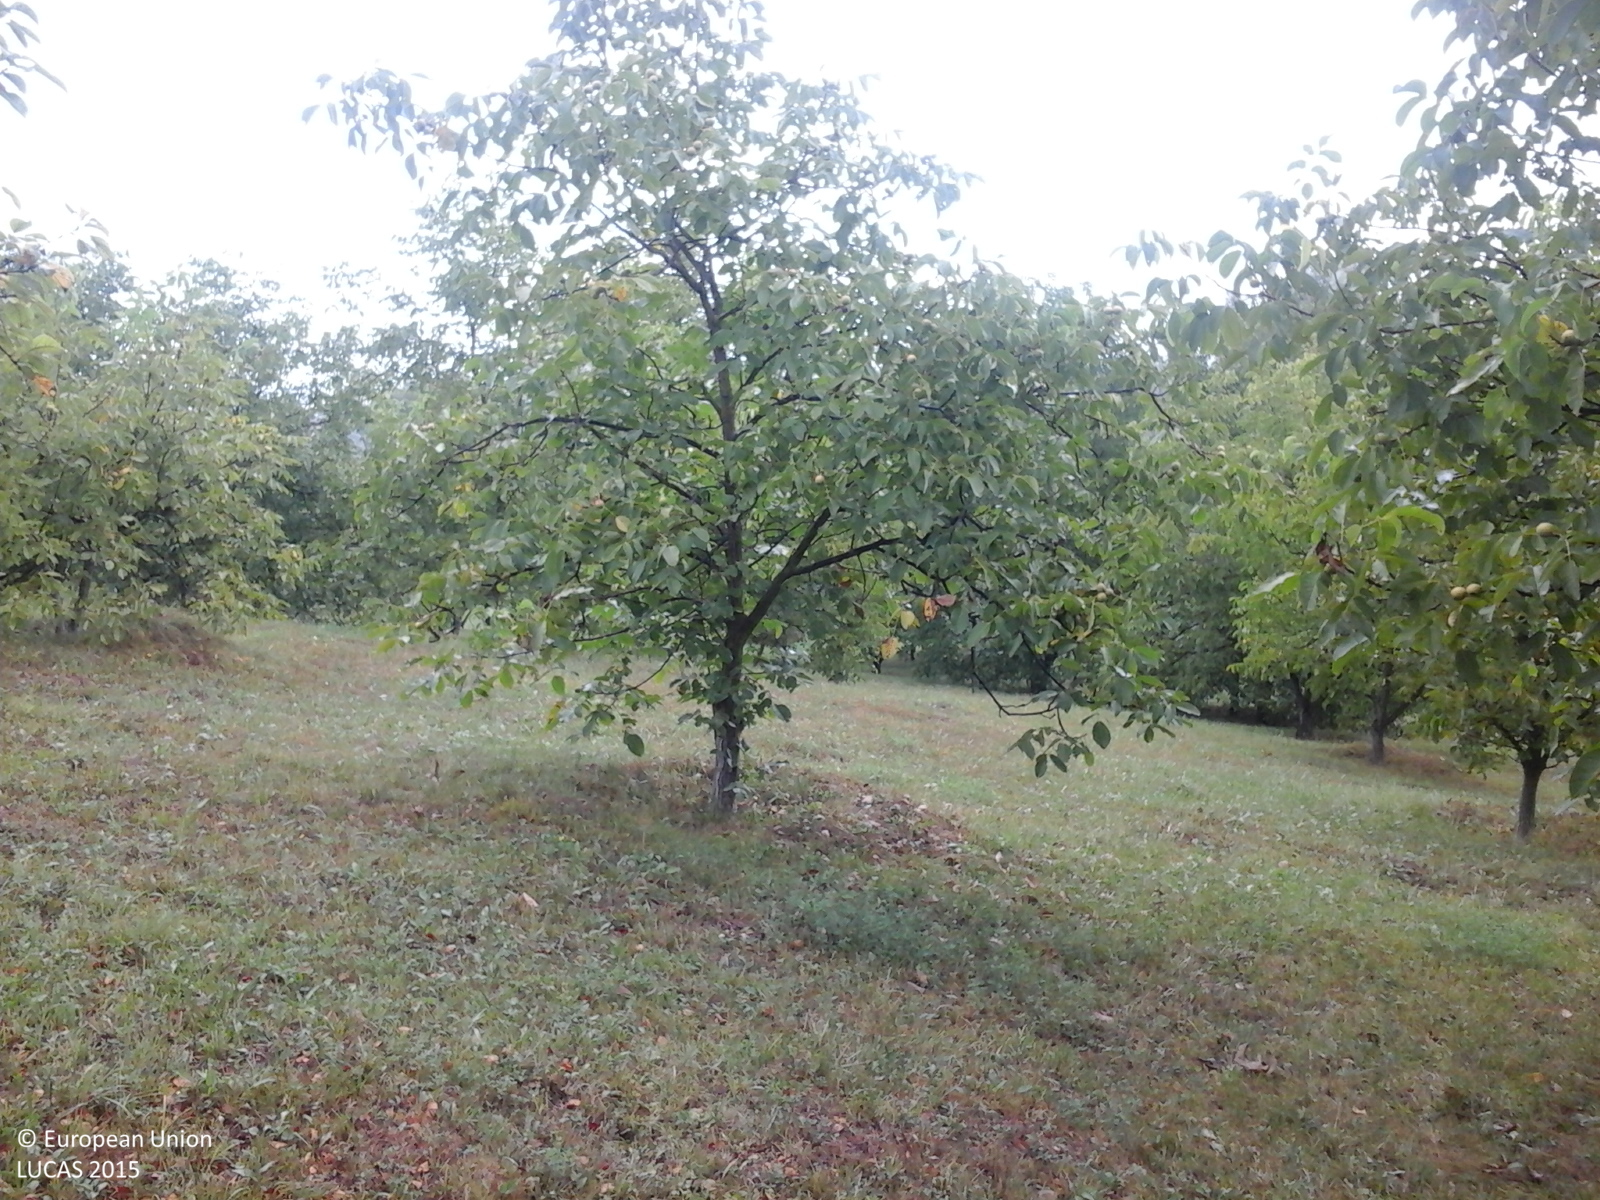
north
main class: Cropland
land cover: Nuts trees
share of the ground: 50 - 75 %
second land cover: Grassland without tree/shrub cover
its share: > 75 %
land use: Agriculture (excluding fallow land and kitchen gardens)
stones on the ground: < 10 %
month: September
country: RO
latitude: 47.9275
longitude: 23.8550
